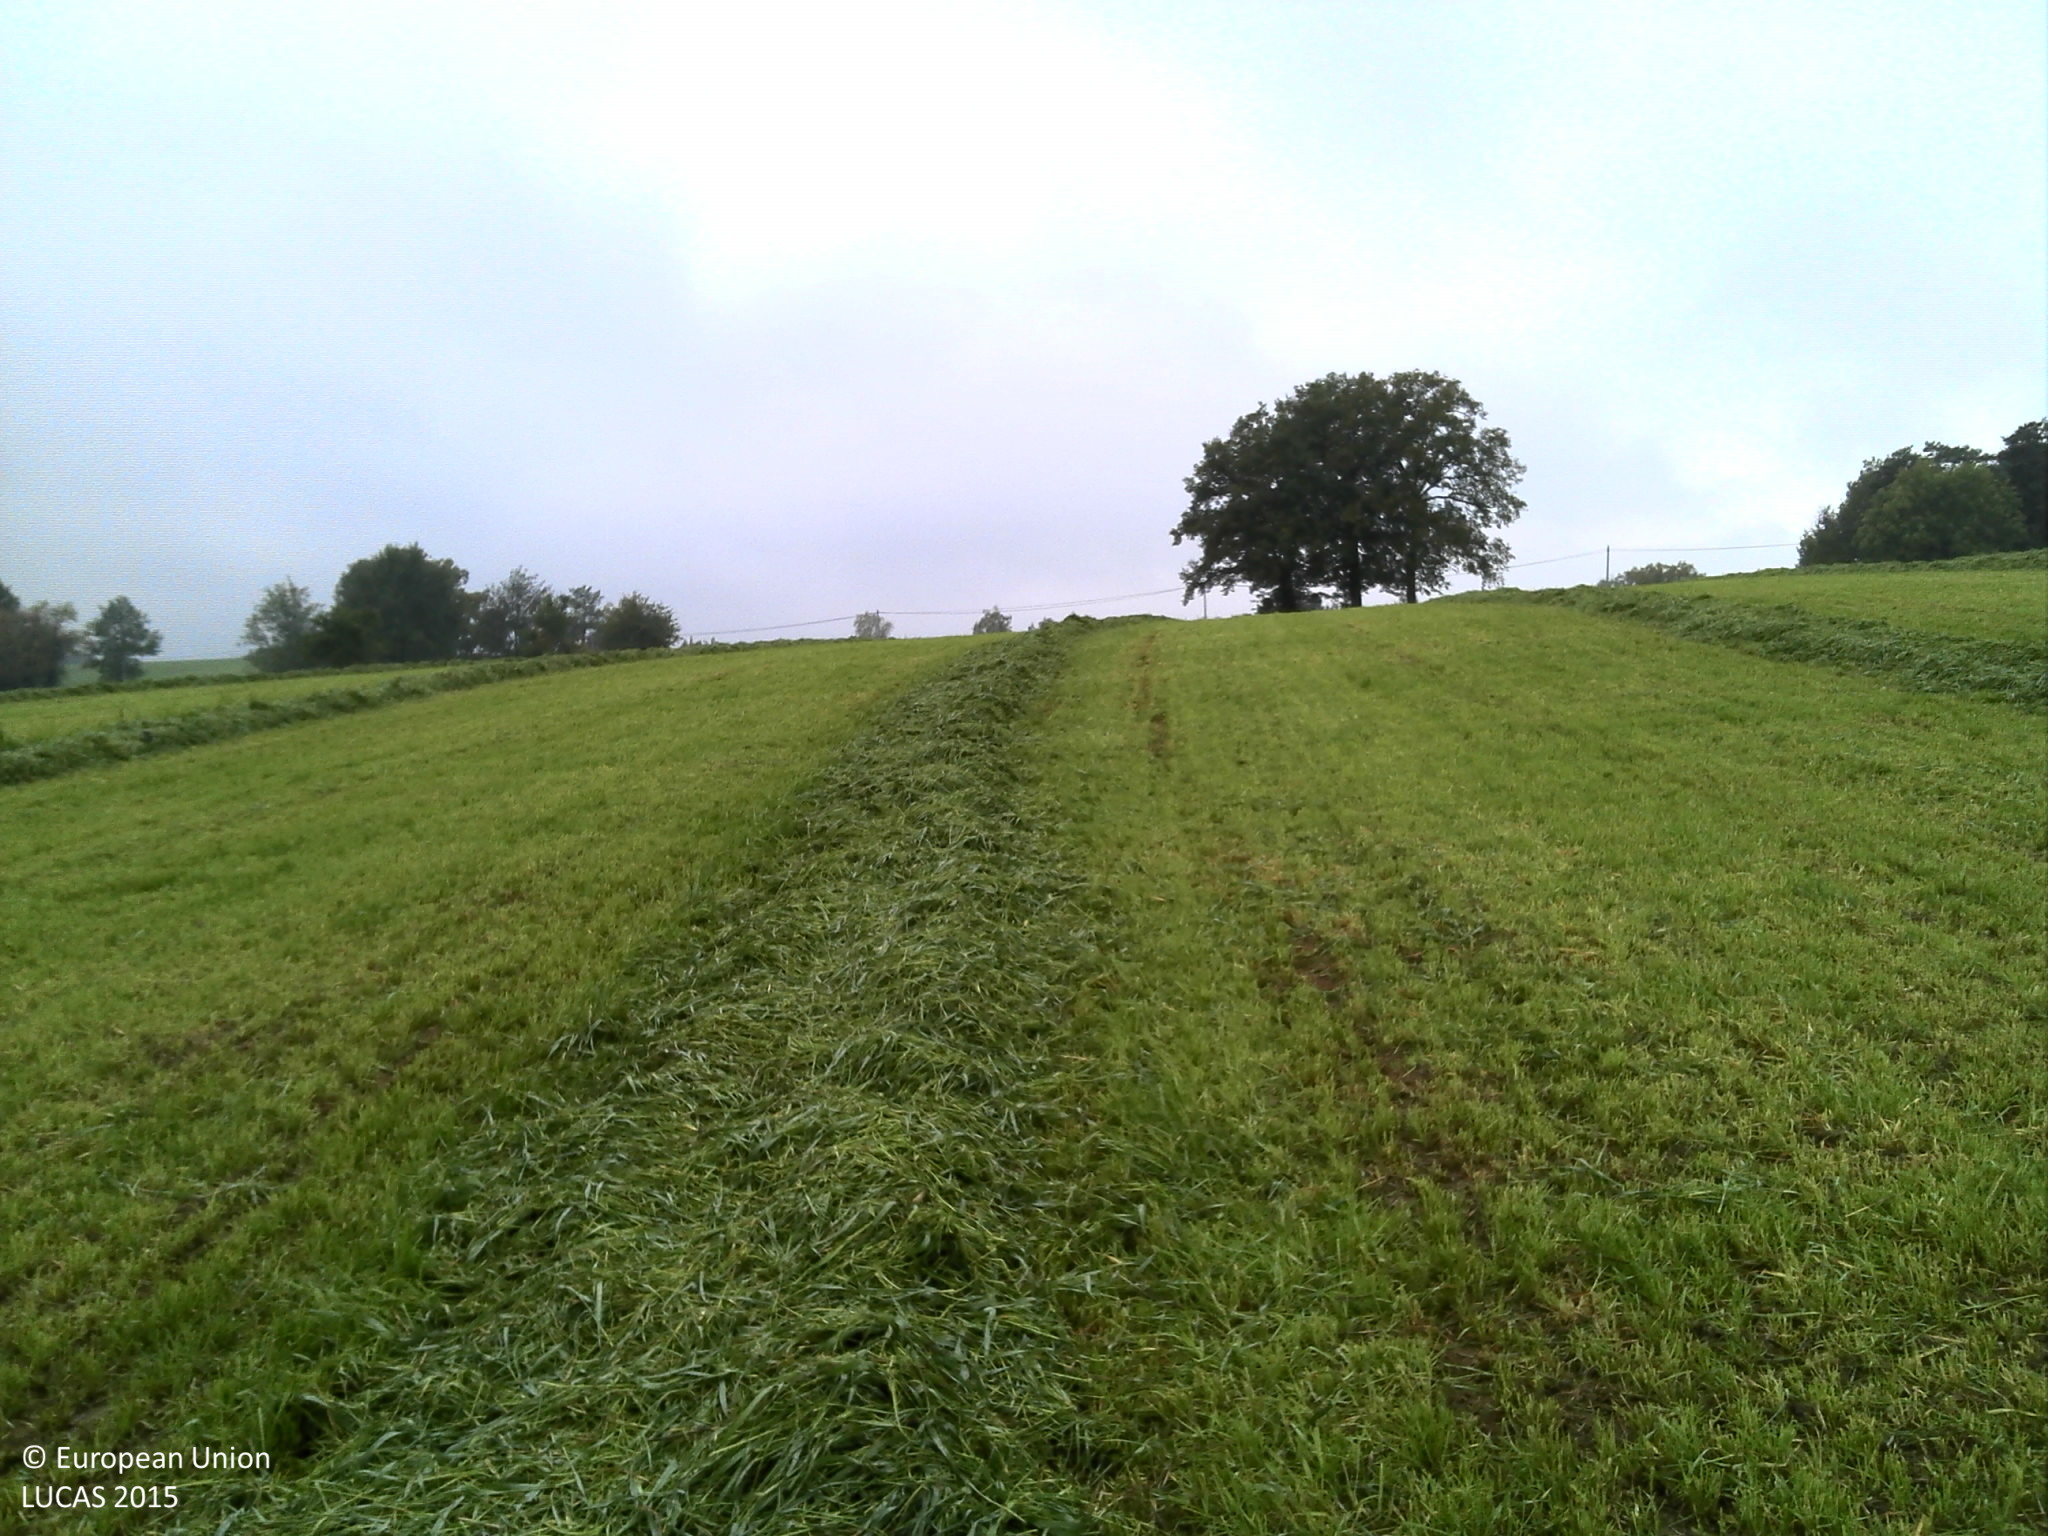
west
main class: Cropland
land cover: Temporary grasslands
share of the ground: > 75 %
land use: Agriculture (excluding fallow land and kitchen gardens)
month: October
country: FR
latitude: 45.6066
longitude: 3.4237
